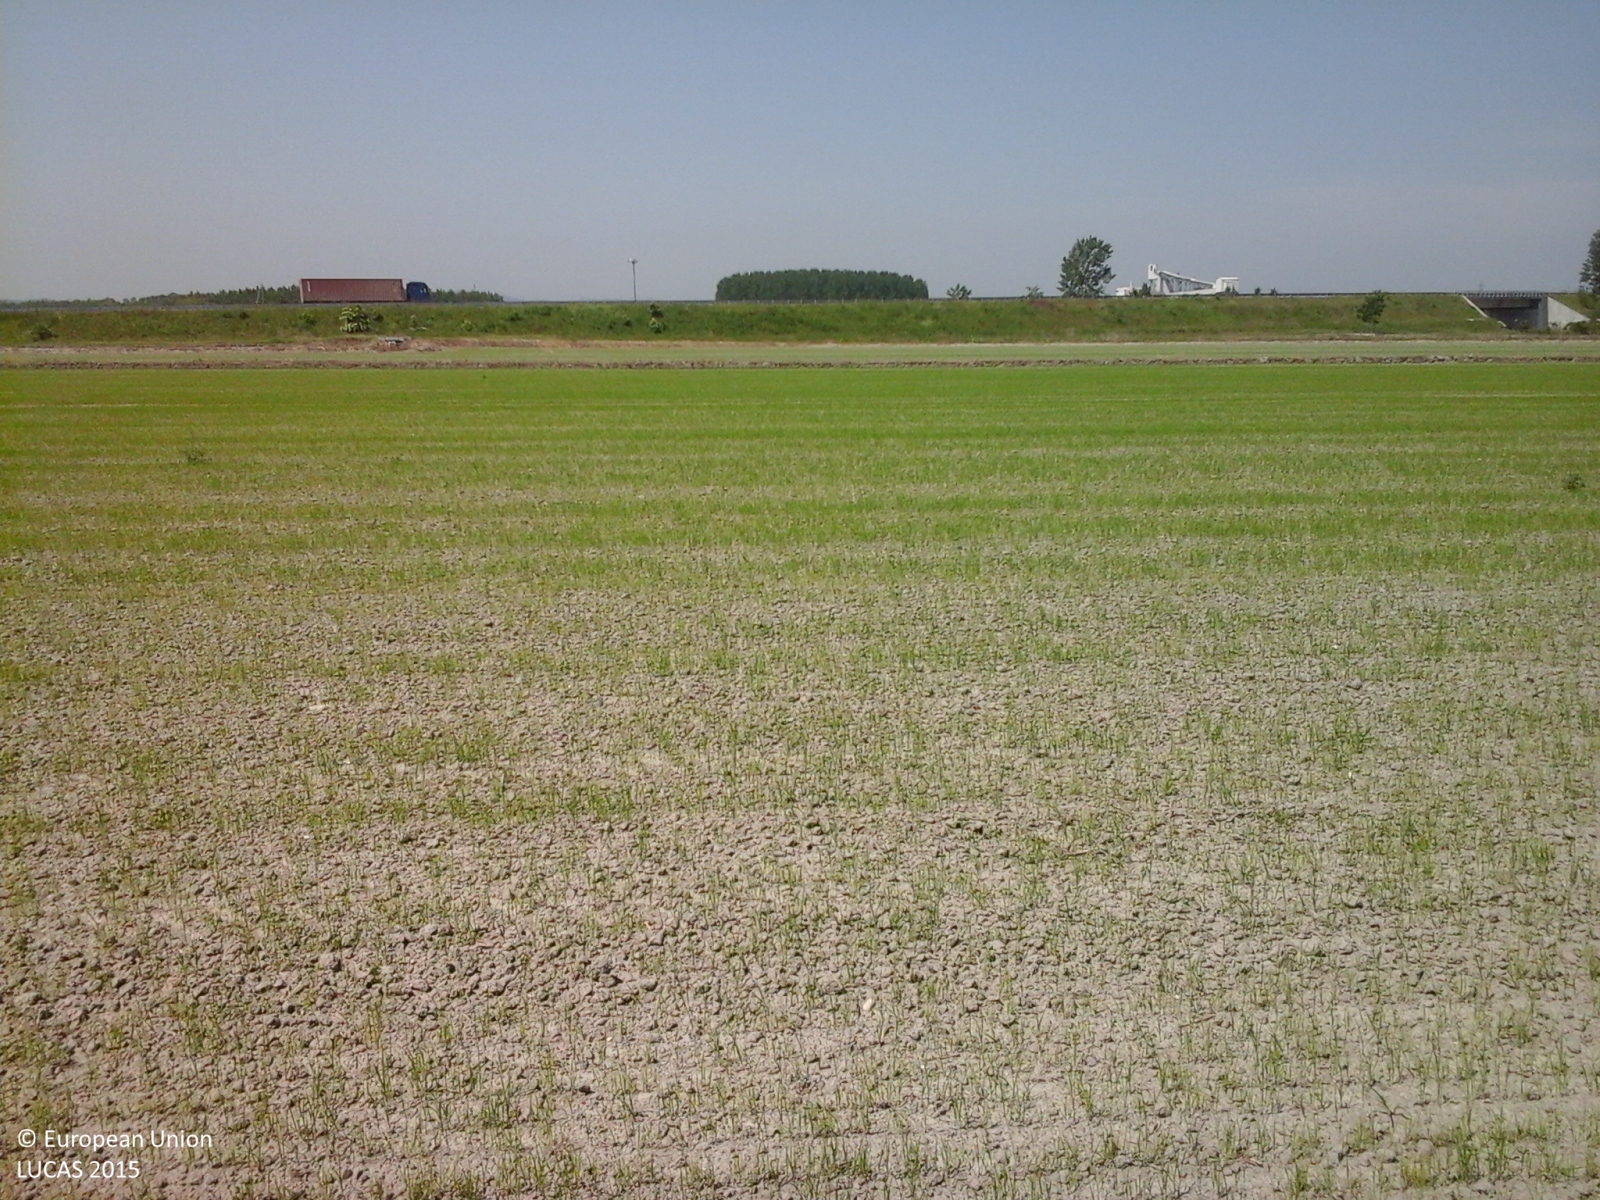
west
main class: Cropland
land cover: Rice
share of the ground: 10 - 25 %
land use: Agriculture (excluding fallow land and kitchen gardens)
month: May
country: IT
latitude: 45.1676
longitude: 8.3871
